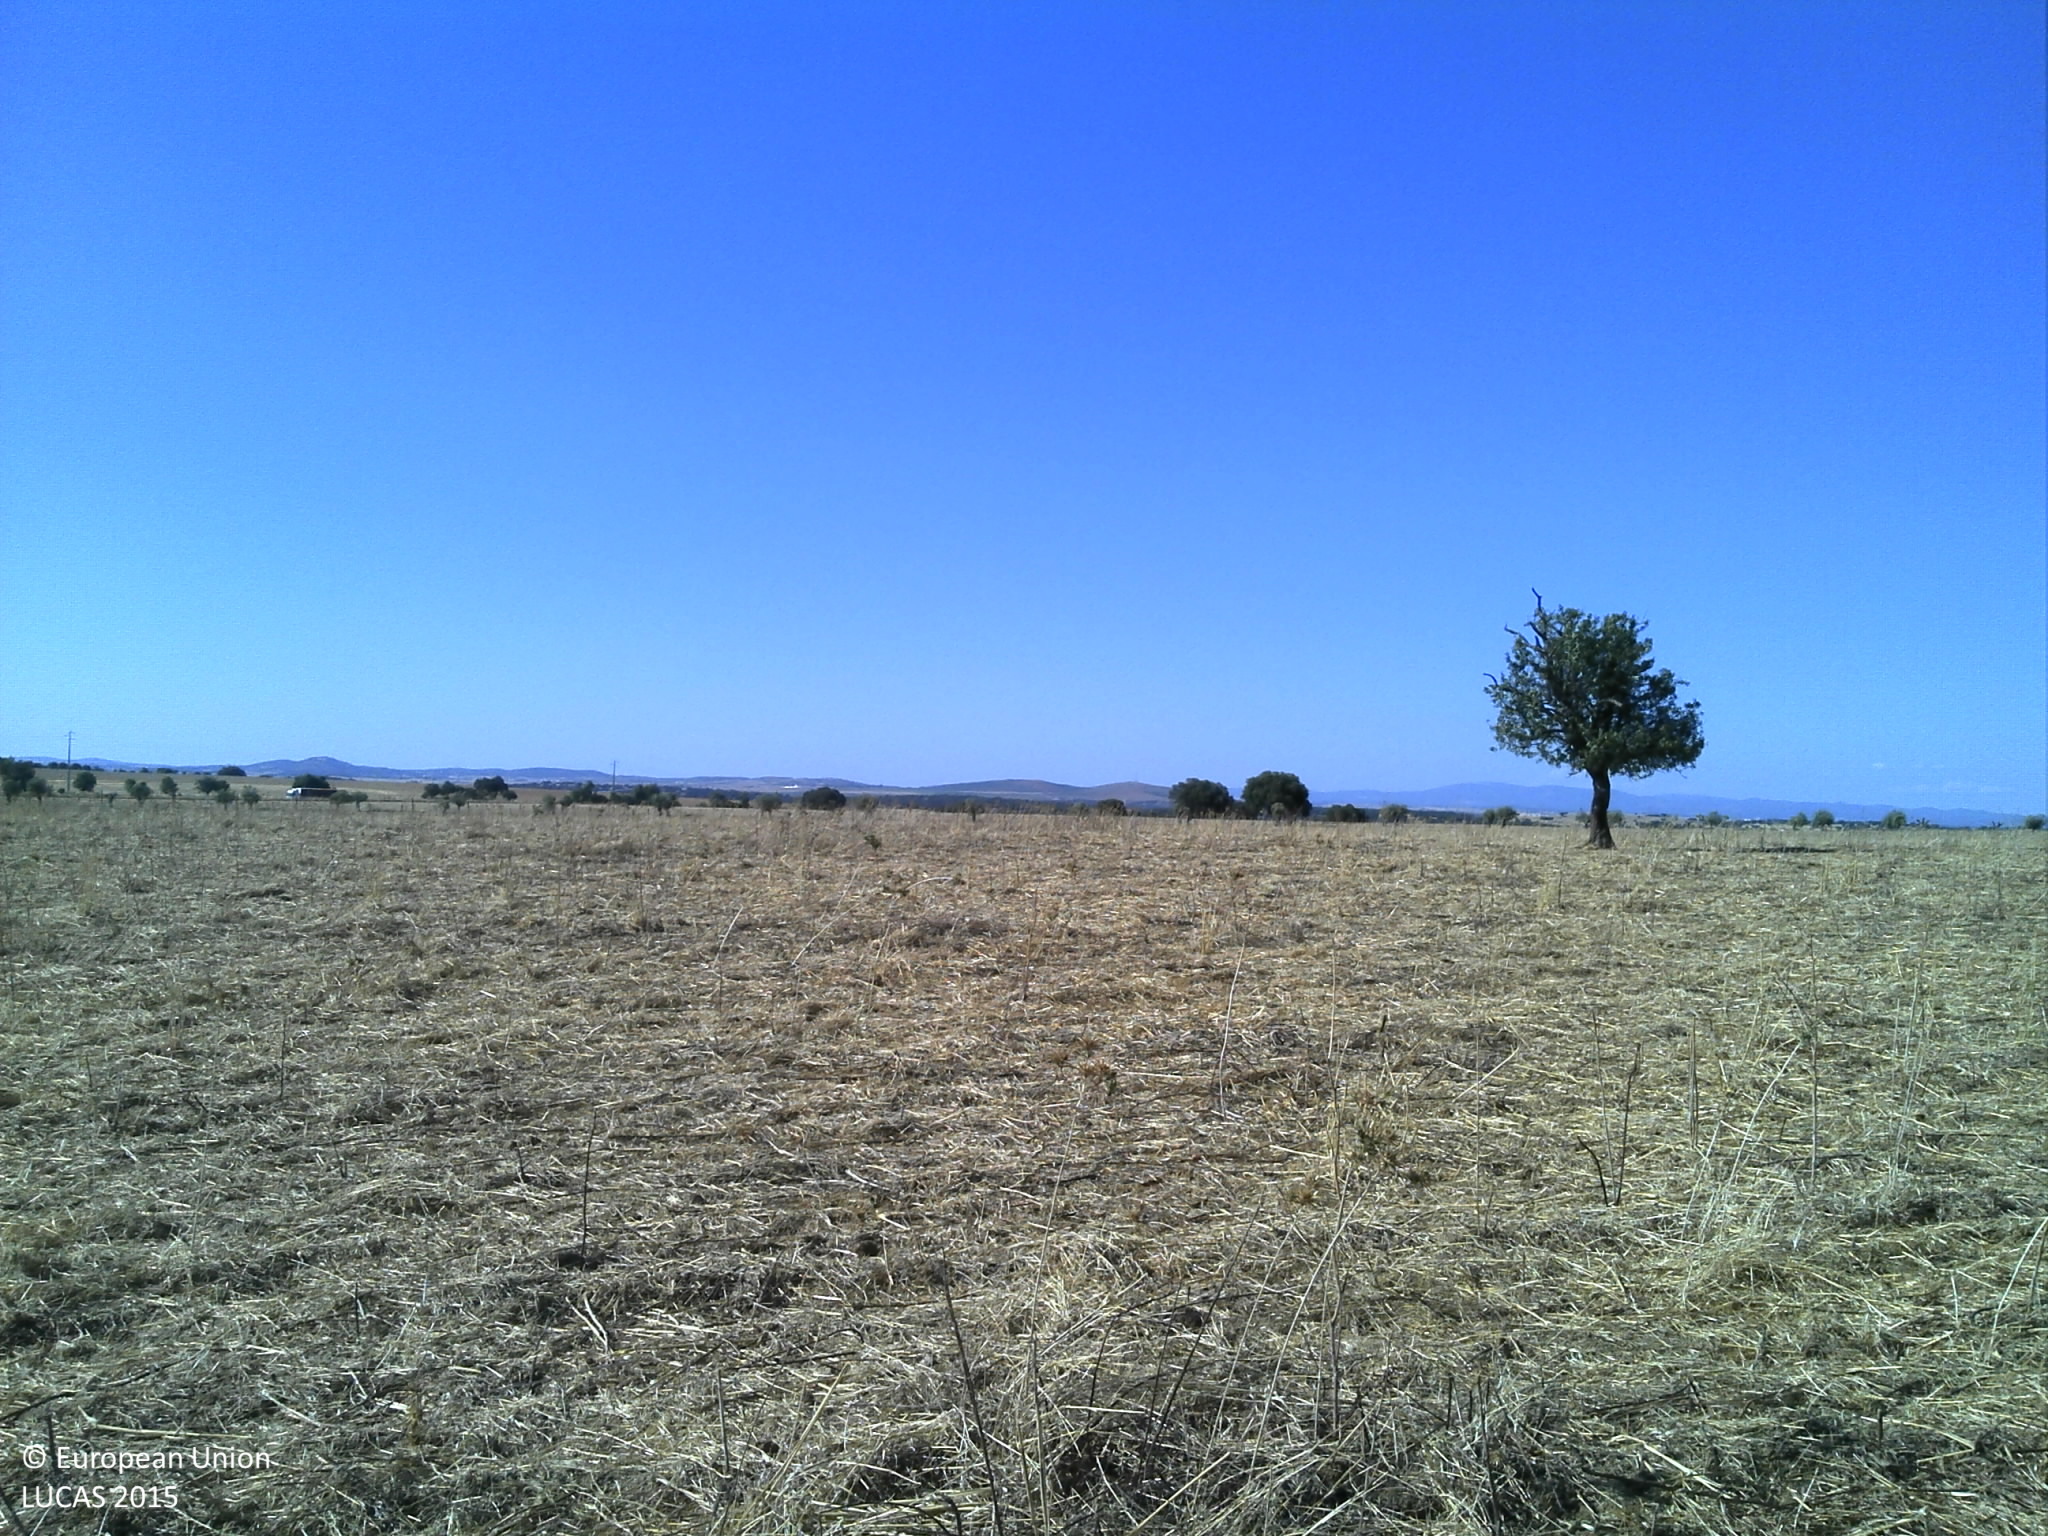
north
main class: Grassland
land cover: Grassland without tree/shrub cover
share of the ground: 10 - 25 %
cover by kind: unconsolidated bare surface 80 %, herbaceous plants 20 %
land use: Agriculture (excluding fallow land and kitchen gardens)
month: July
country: PT
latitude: 38.9799
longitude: -7.4790
